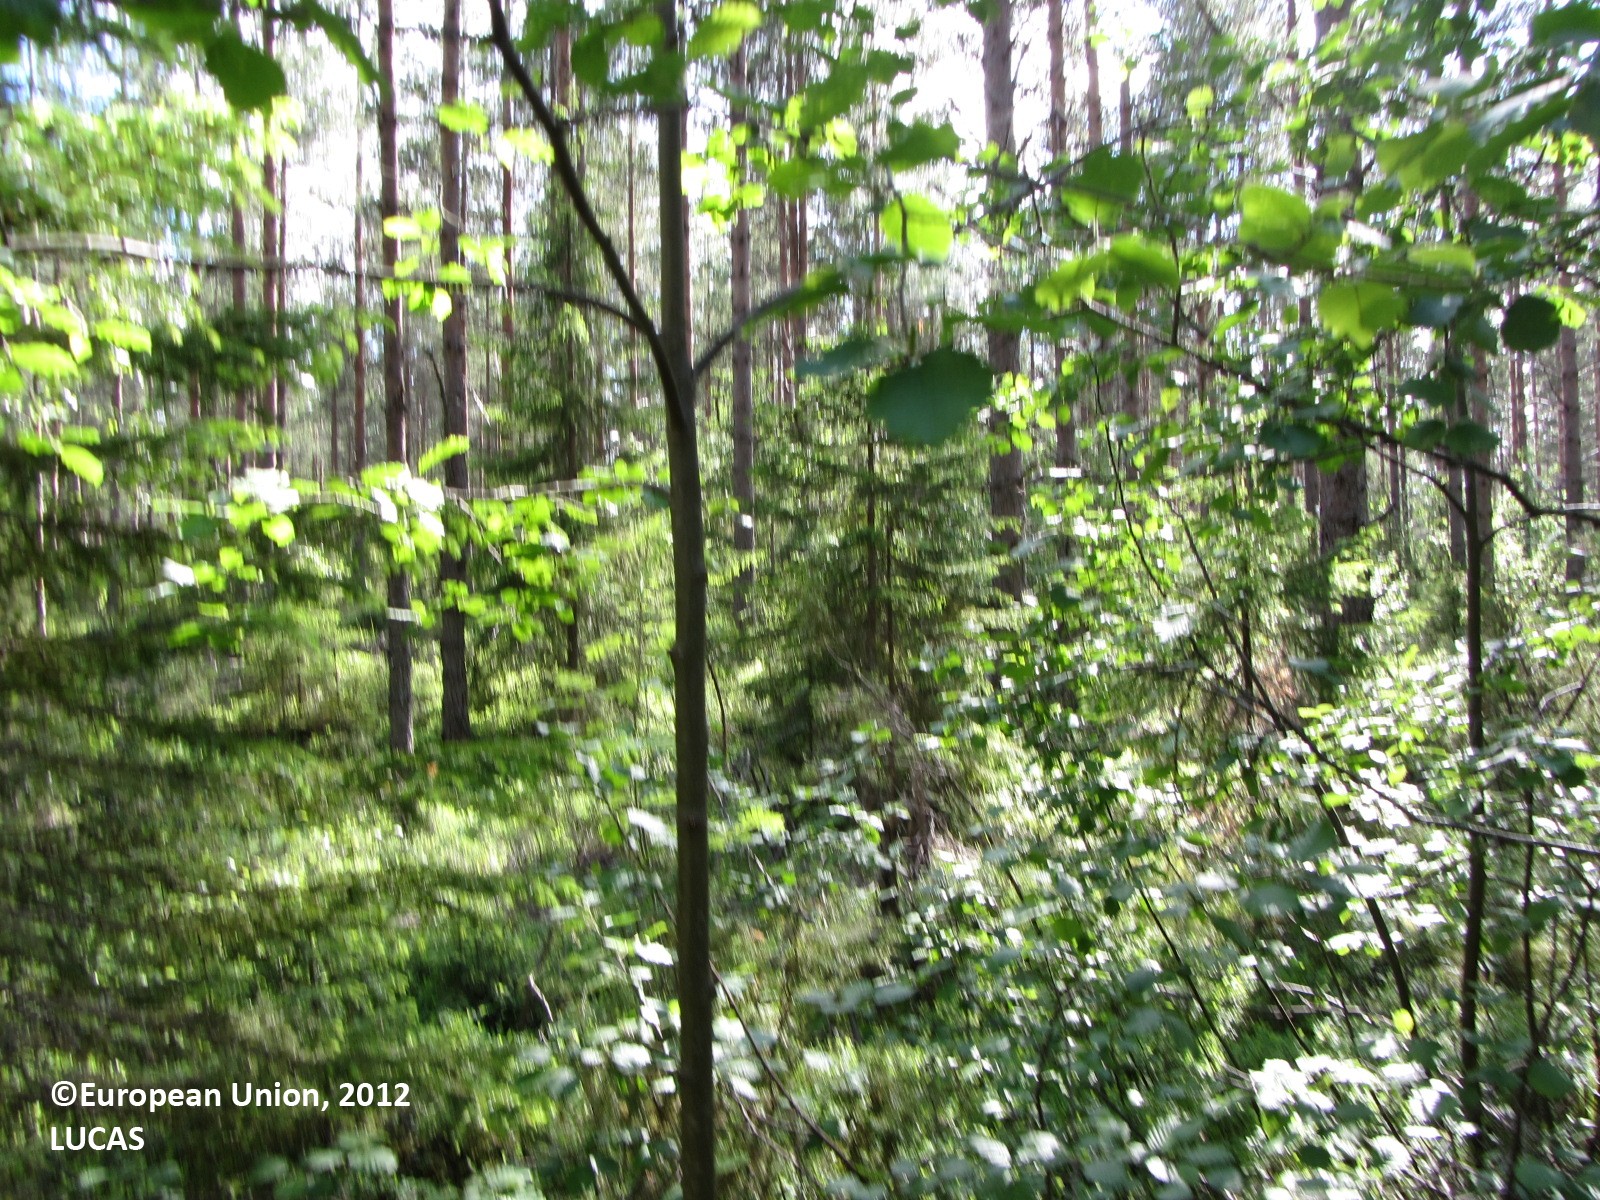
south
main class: Woodland
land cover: Pine dominated coniferous woodland
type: boreal forest
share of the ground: > 75 %
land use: Forestry
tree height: > 5 m
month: June
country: FI
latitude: 62.2708
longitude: 25.0730
